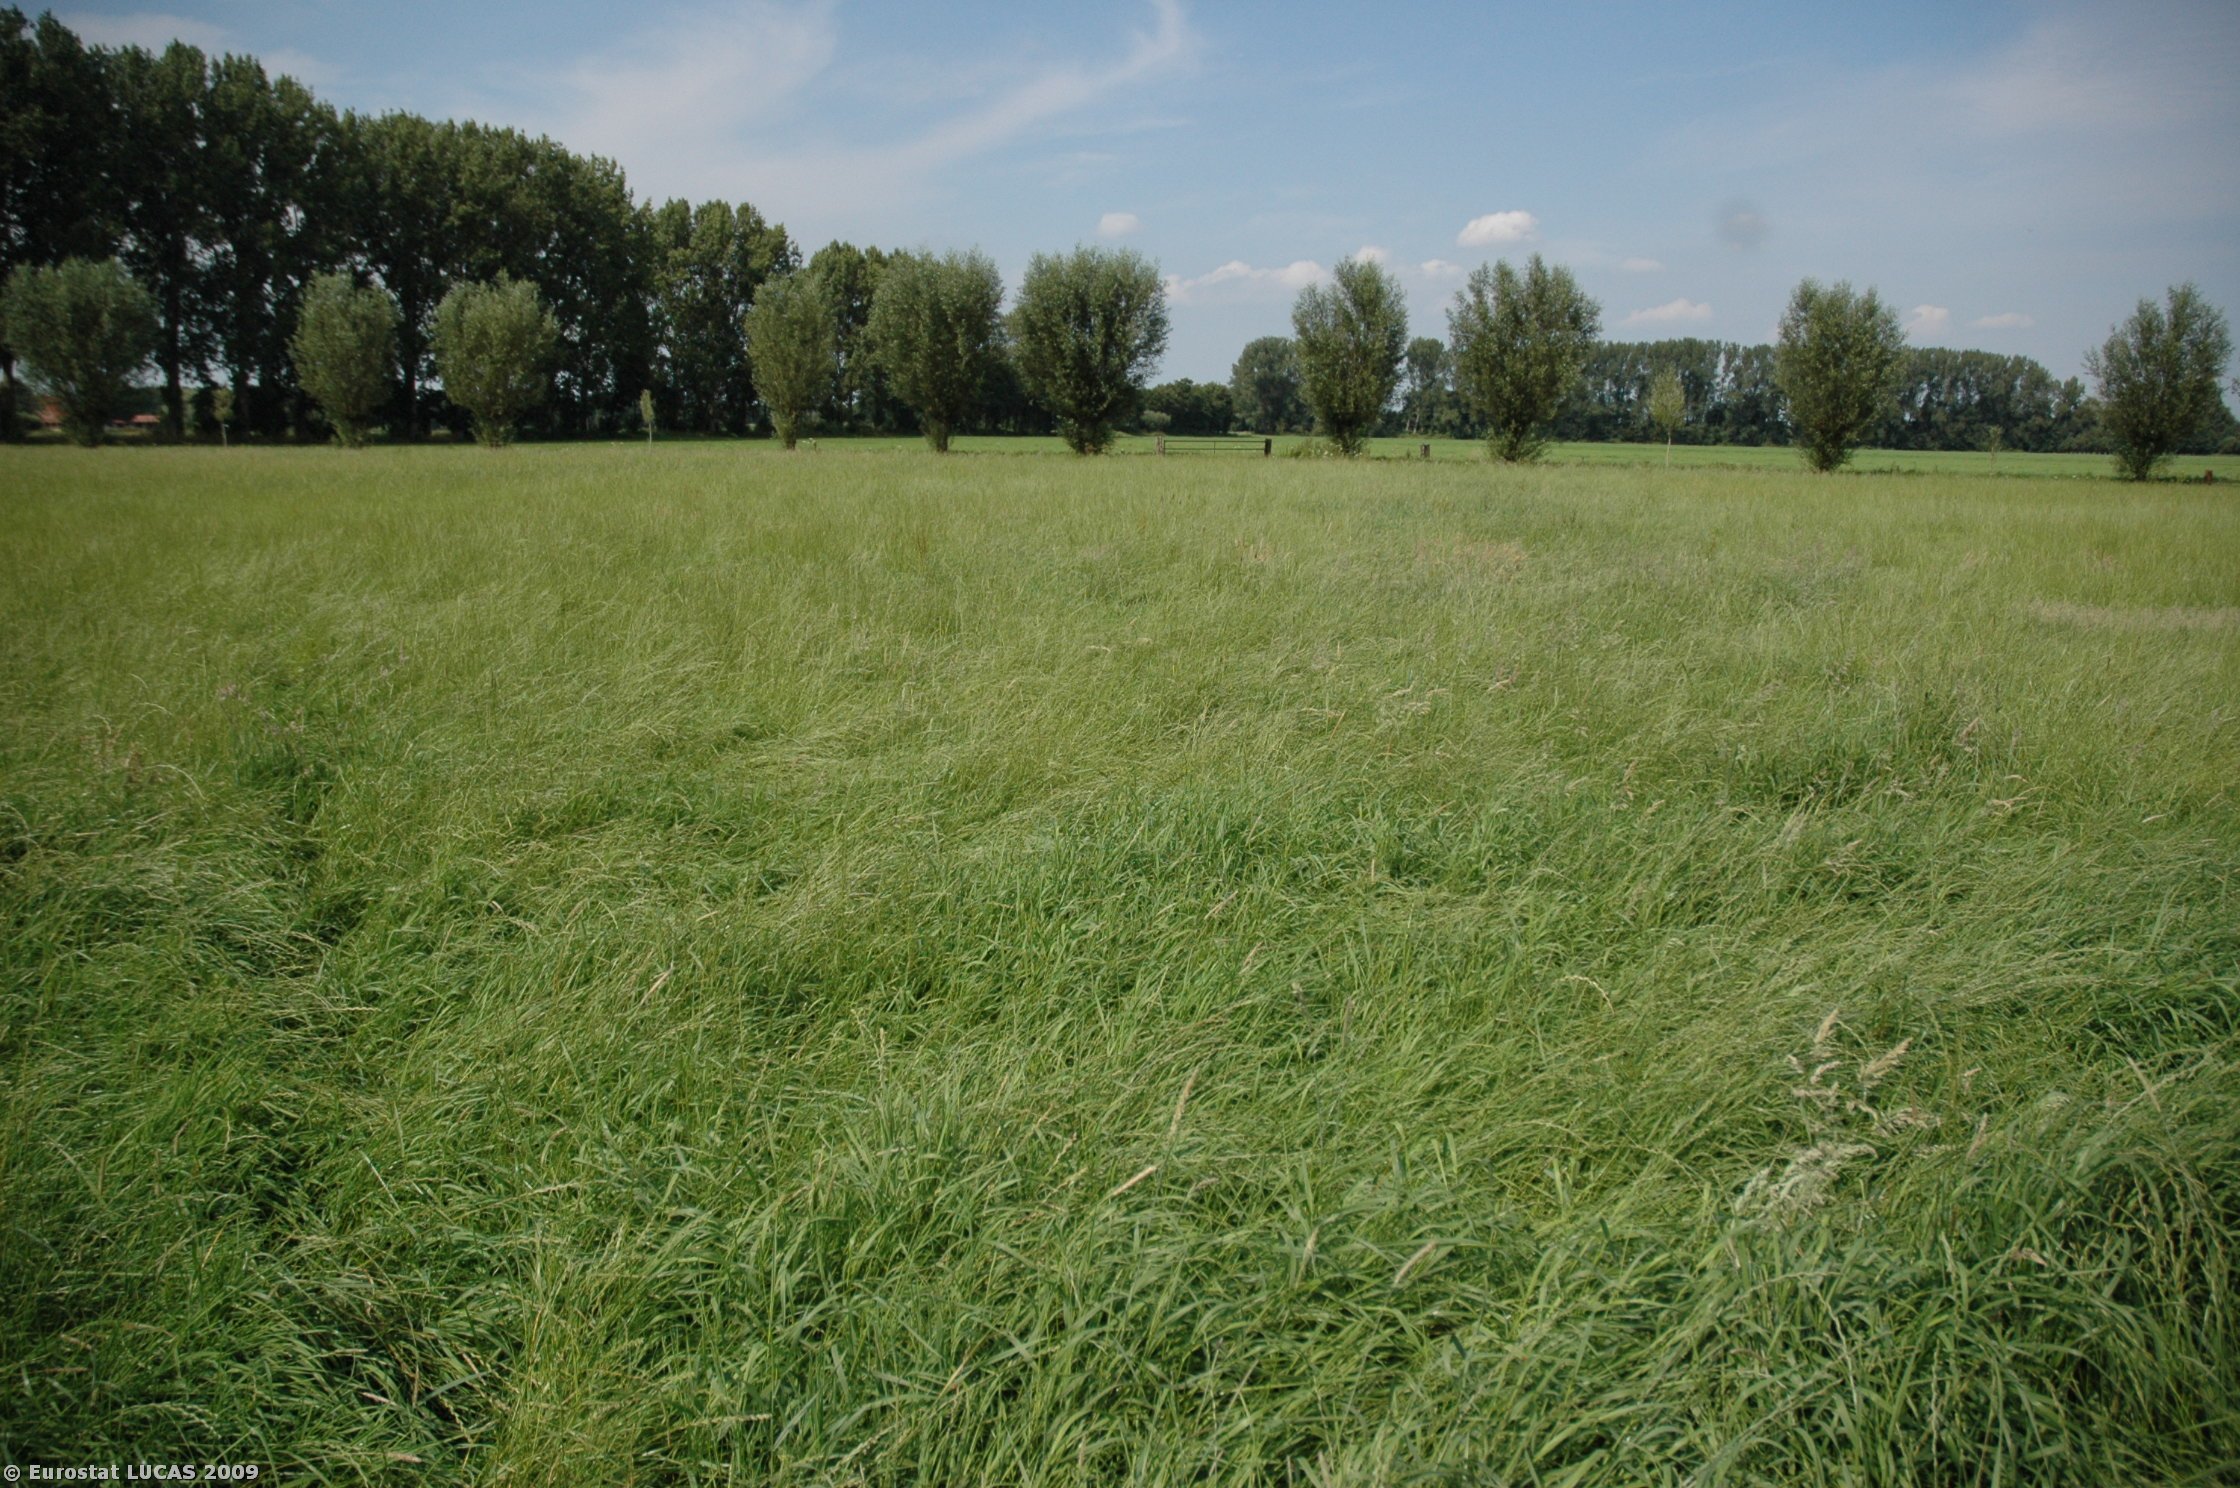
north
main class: Grassland
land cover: Grassland without tree/shrub cover
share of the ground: > 75 %
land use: Agriculture (excluding fallow land and kitchen gardens)
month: August
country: NL
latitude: 52.4026
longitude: 6.0749
